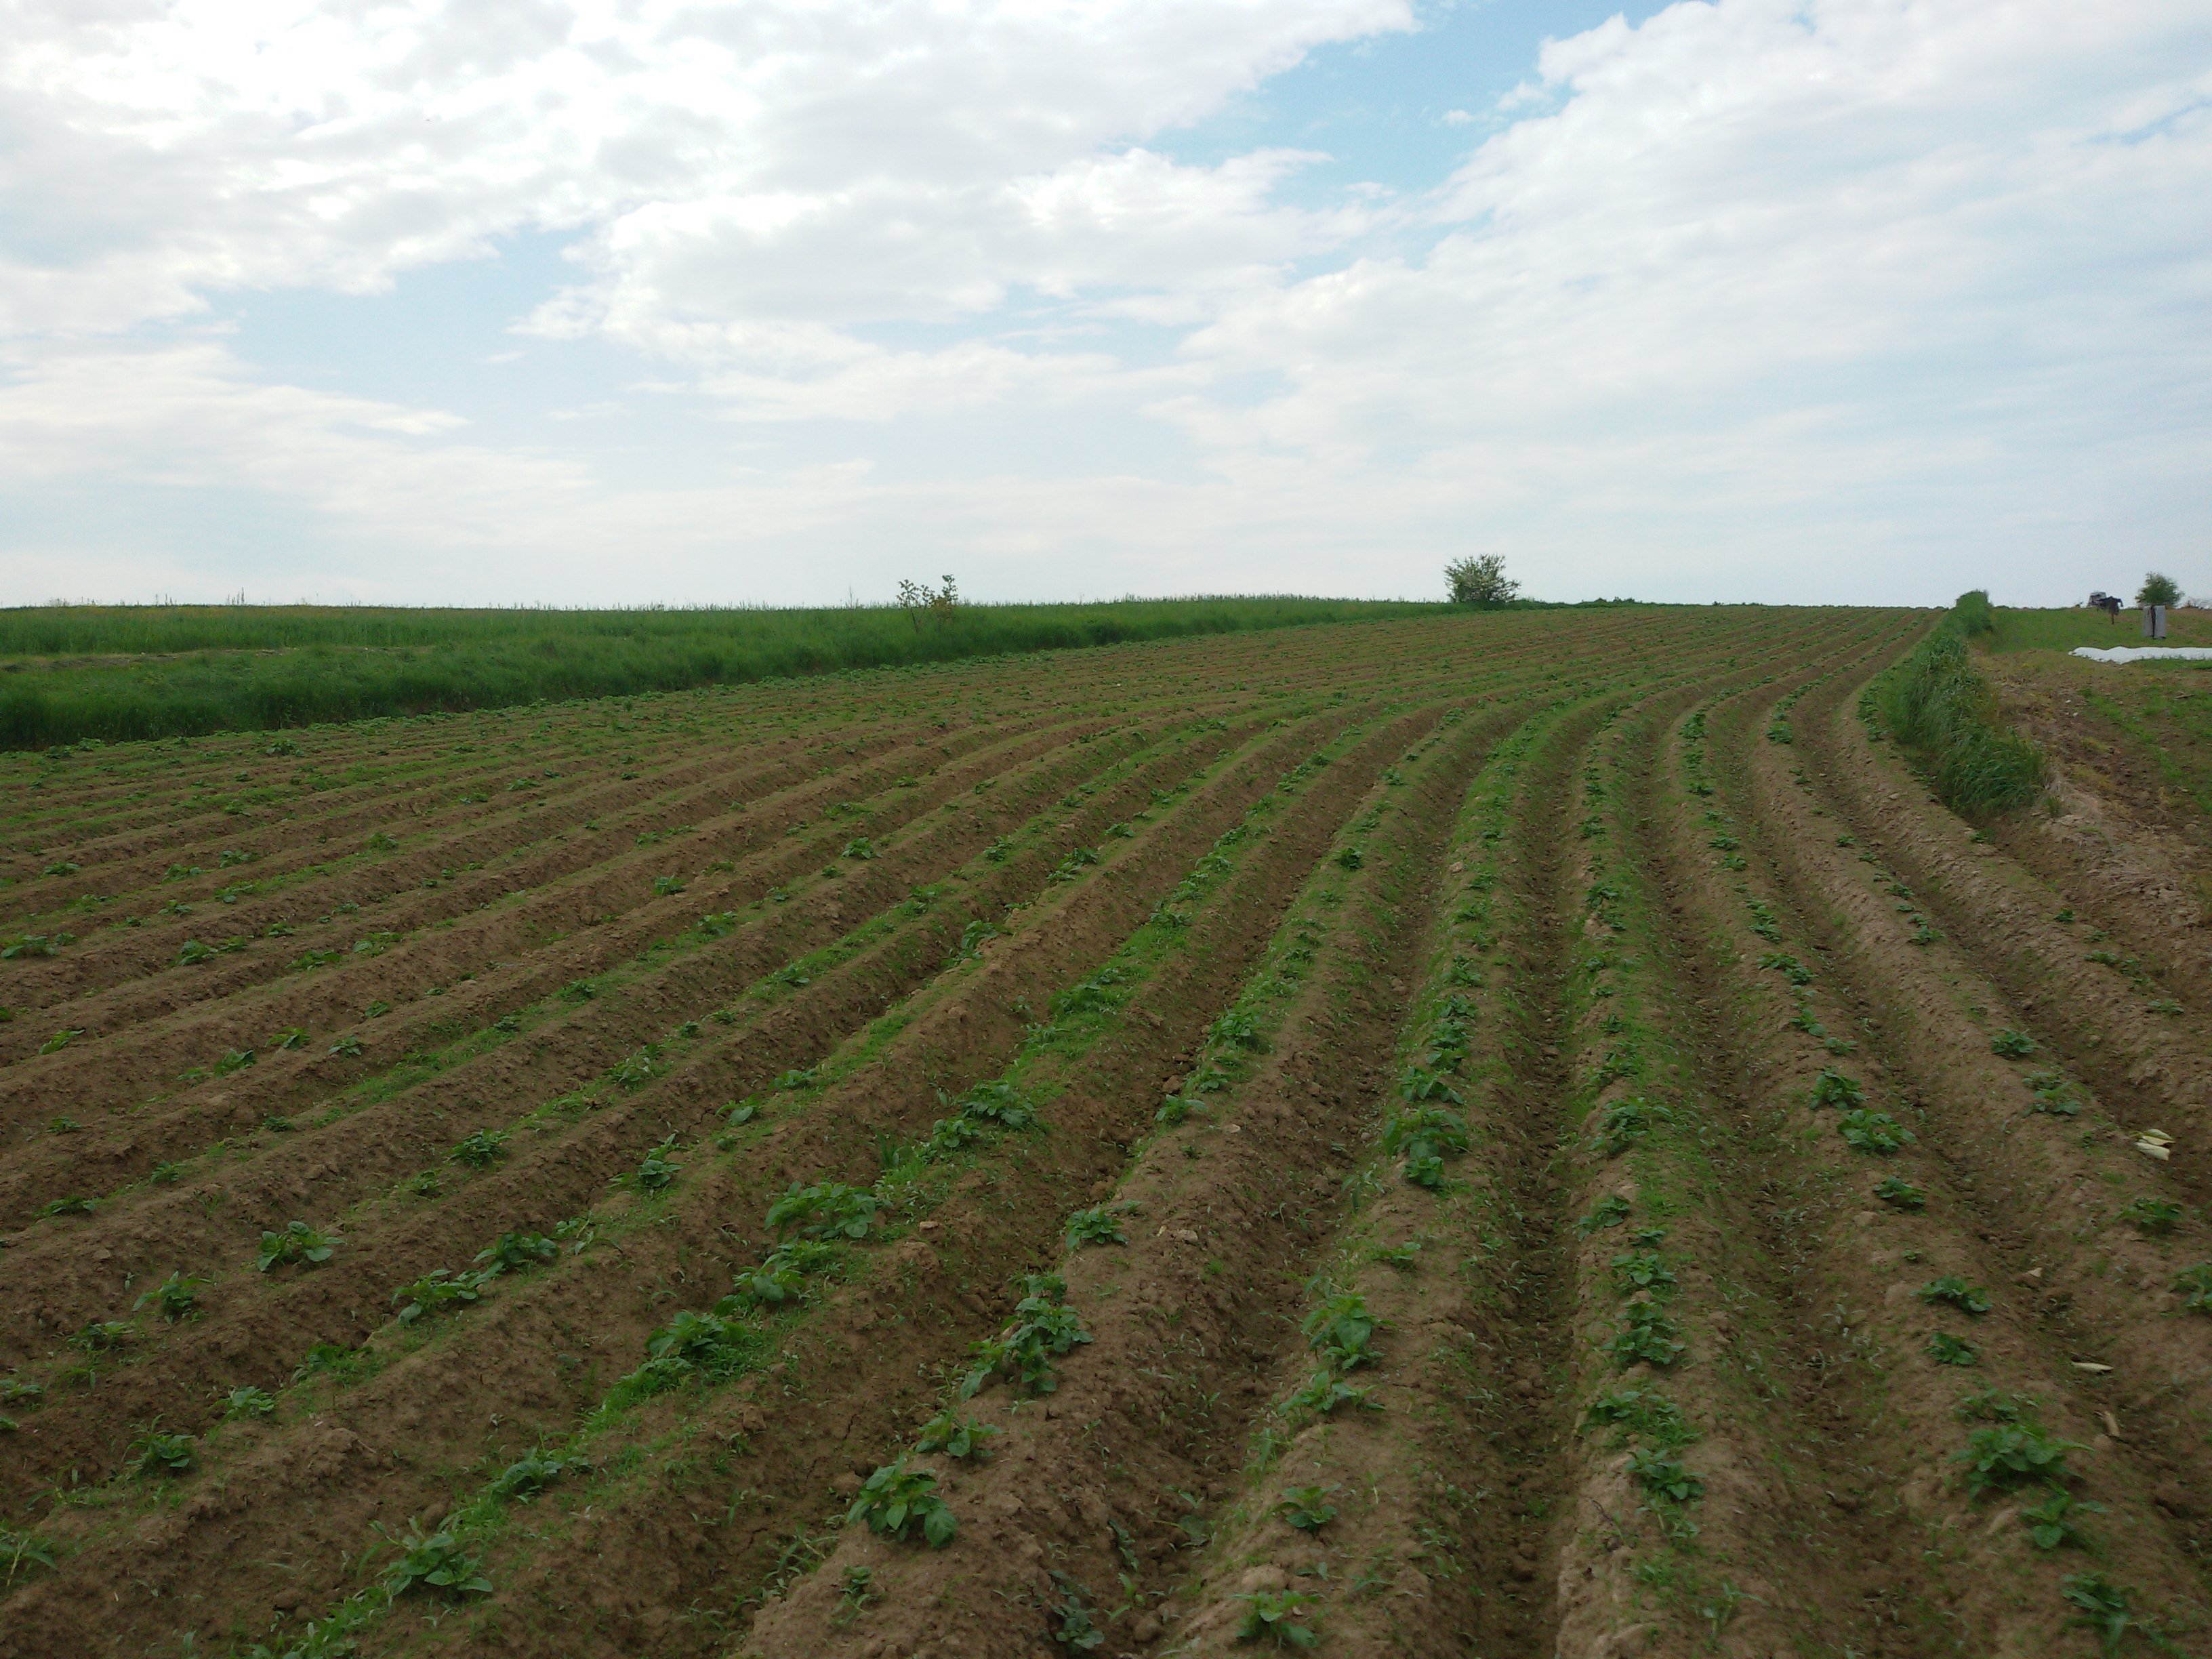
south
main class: Cropland
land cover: Potatoes
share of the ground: < 10 %
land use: Agriculture (excluding fallow land and kitchen gardens)
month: May
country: PL
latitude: 50.1104
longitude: 21.3042
